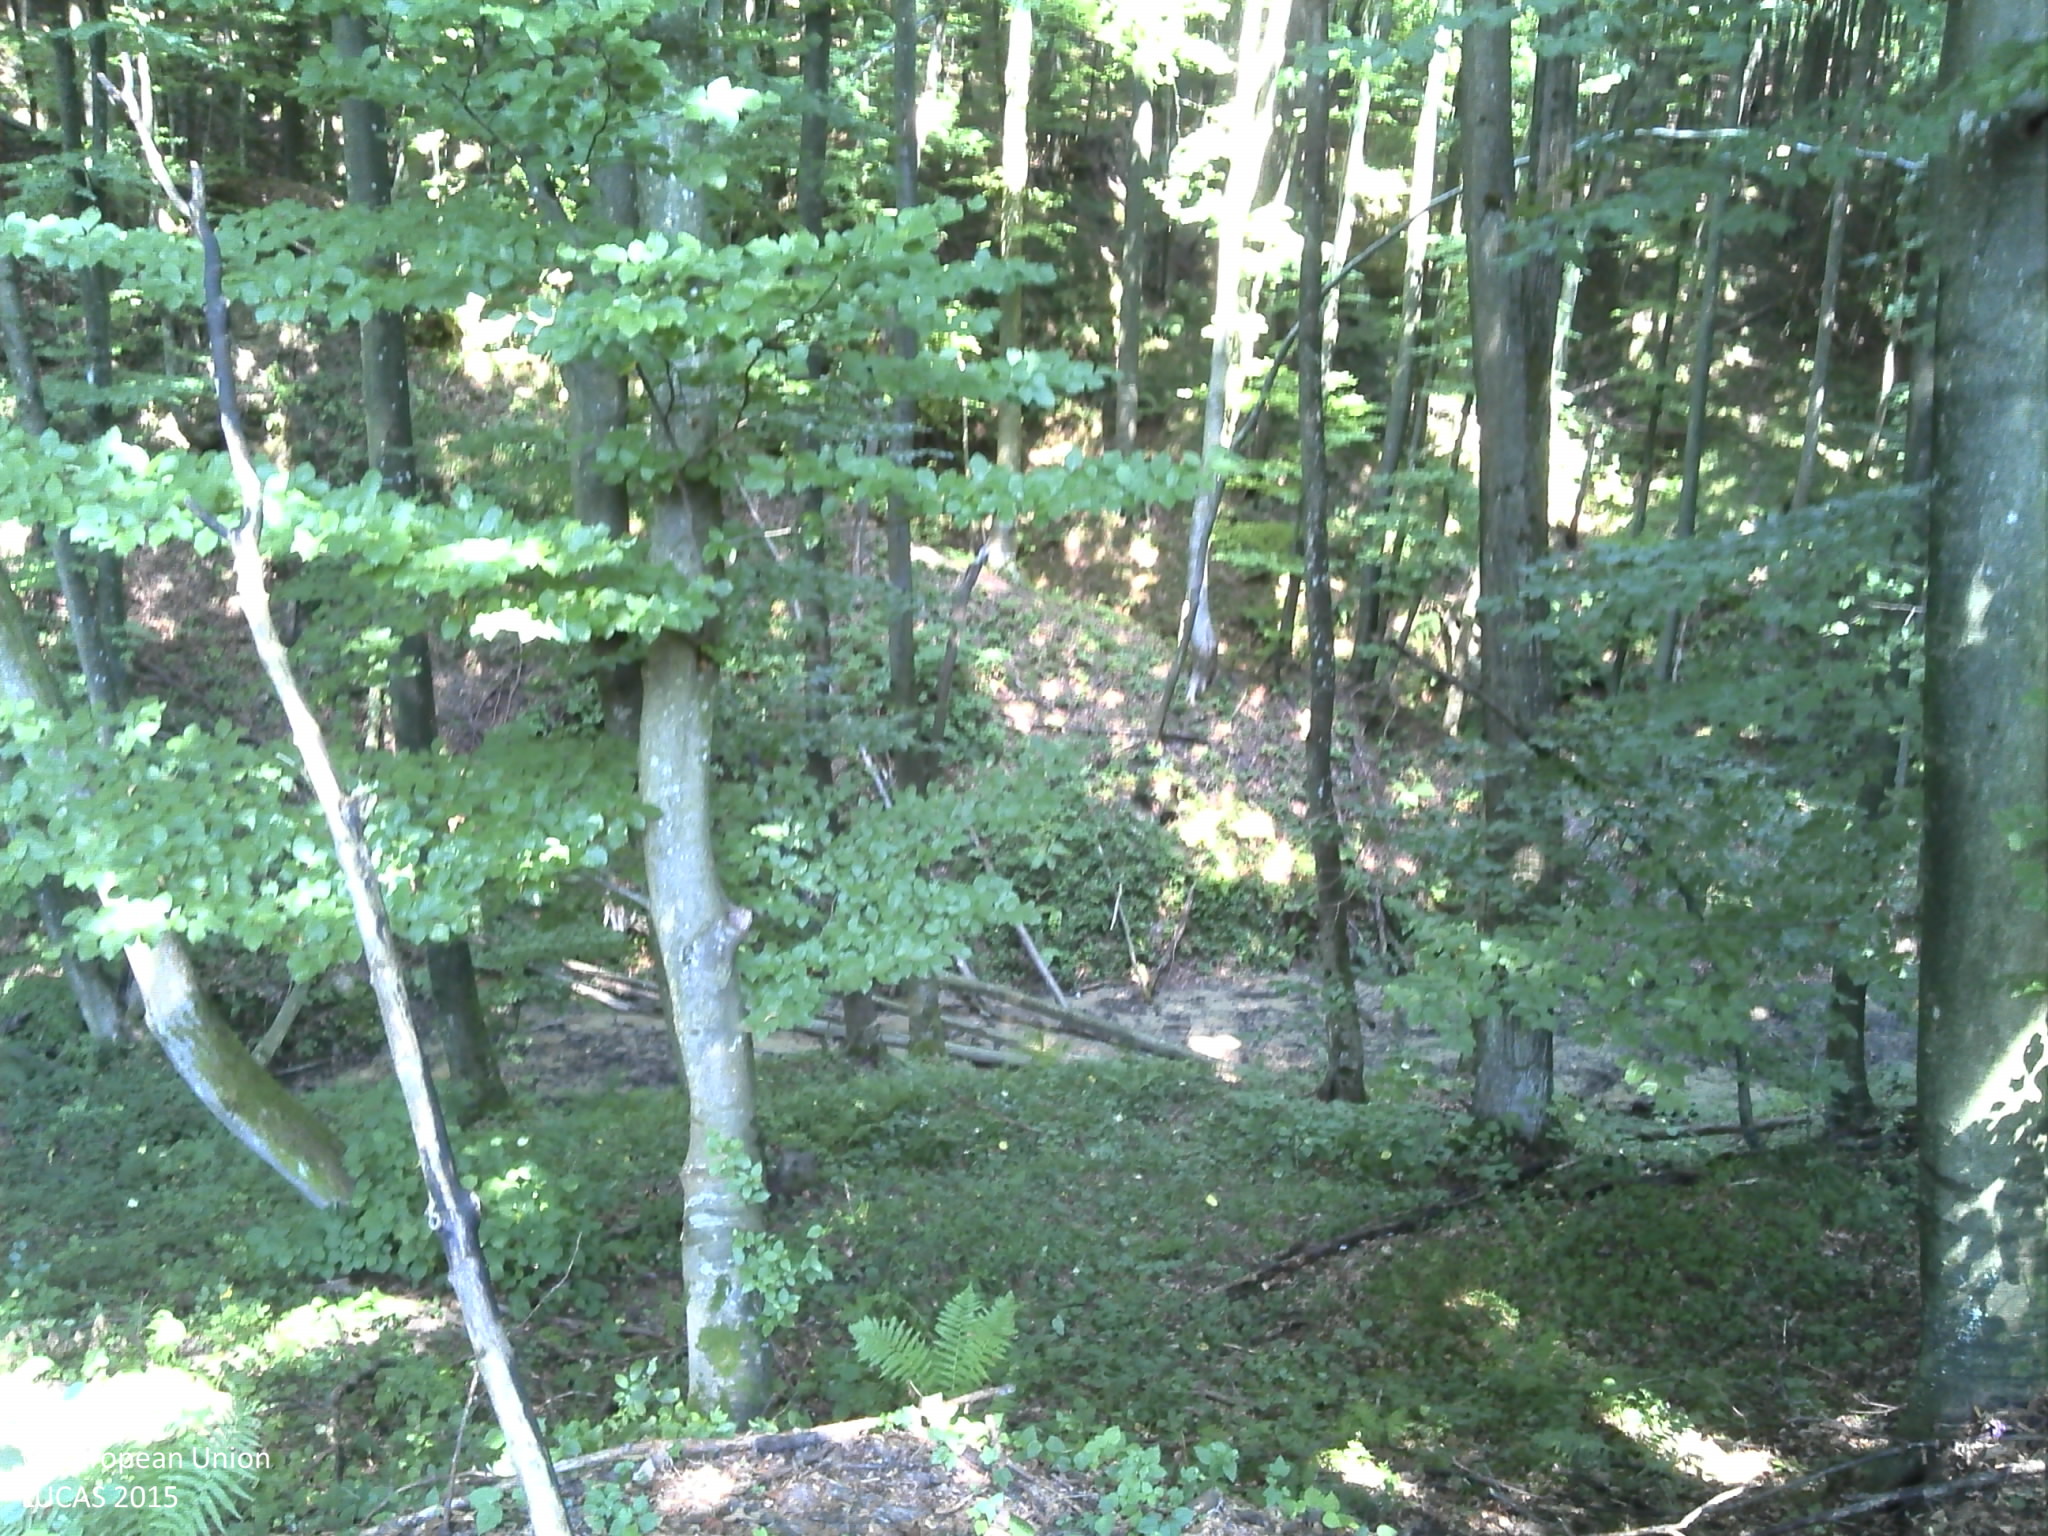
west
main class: Woodland
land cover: Broadleaved woodland
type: beech forest
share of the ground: > 75 %
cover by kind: broadleaved forest trees 100 %
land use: Forestry
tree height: > 5 m
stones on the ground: < 10 %
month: August
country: HR
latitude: 45.7639
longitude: 17.2146
